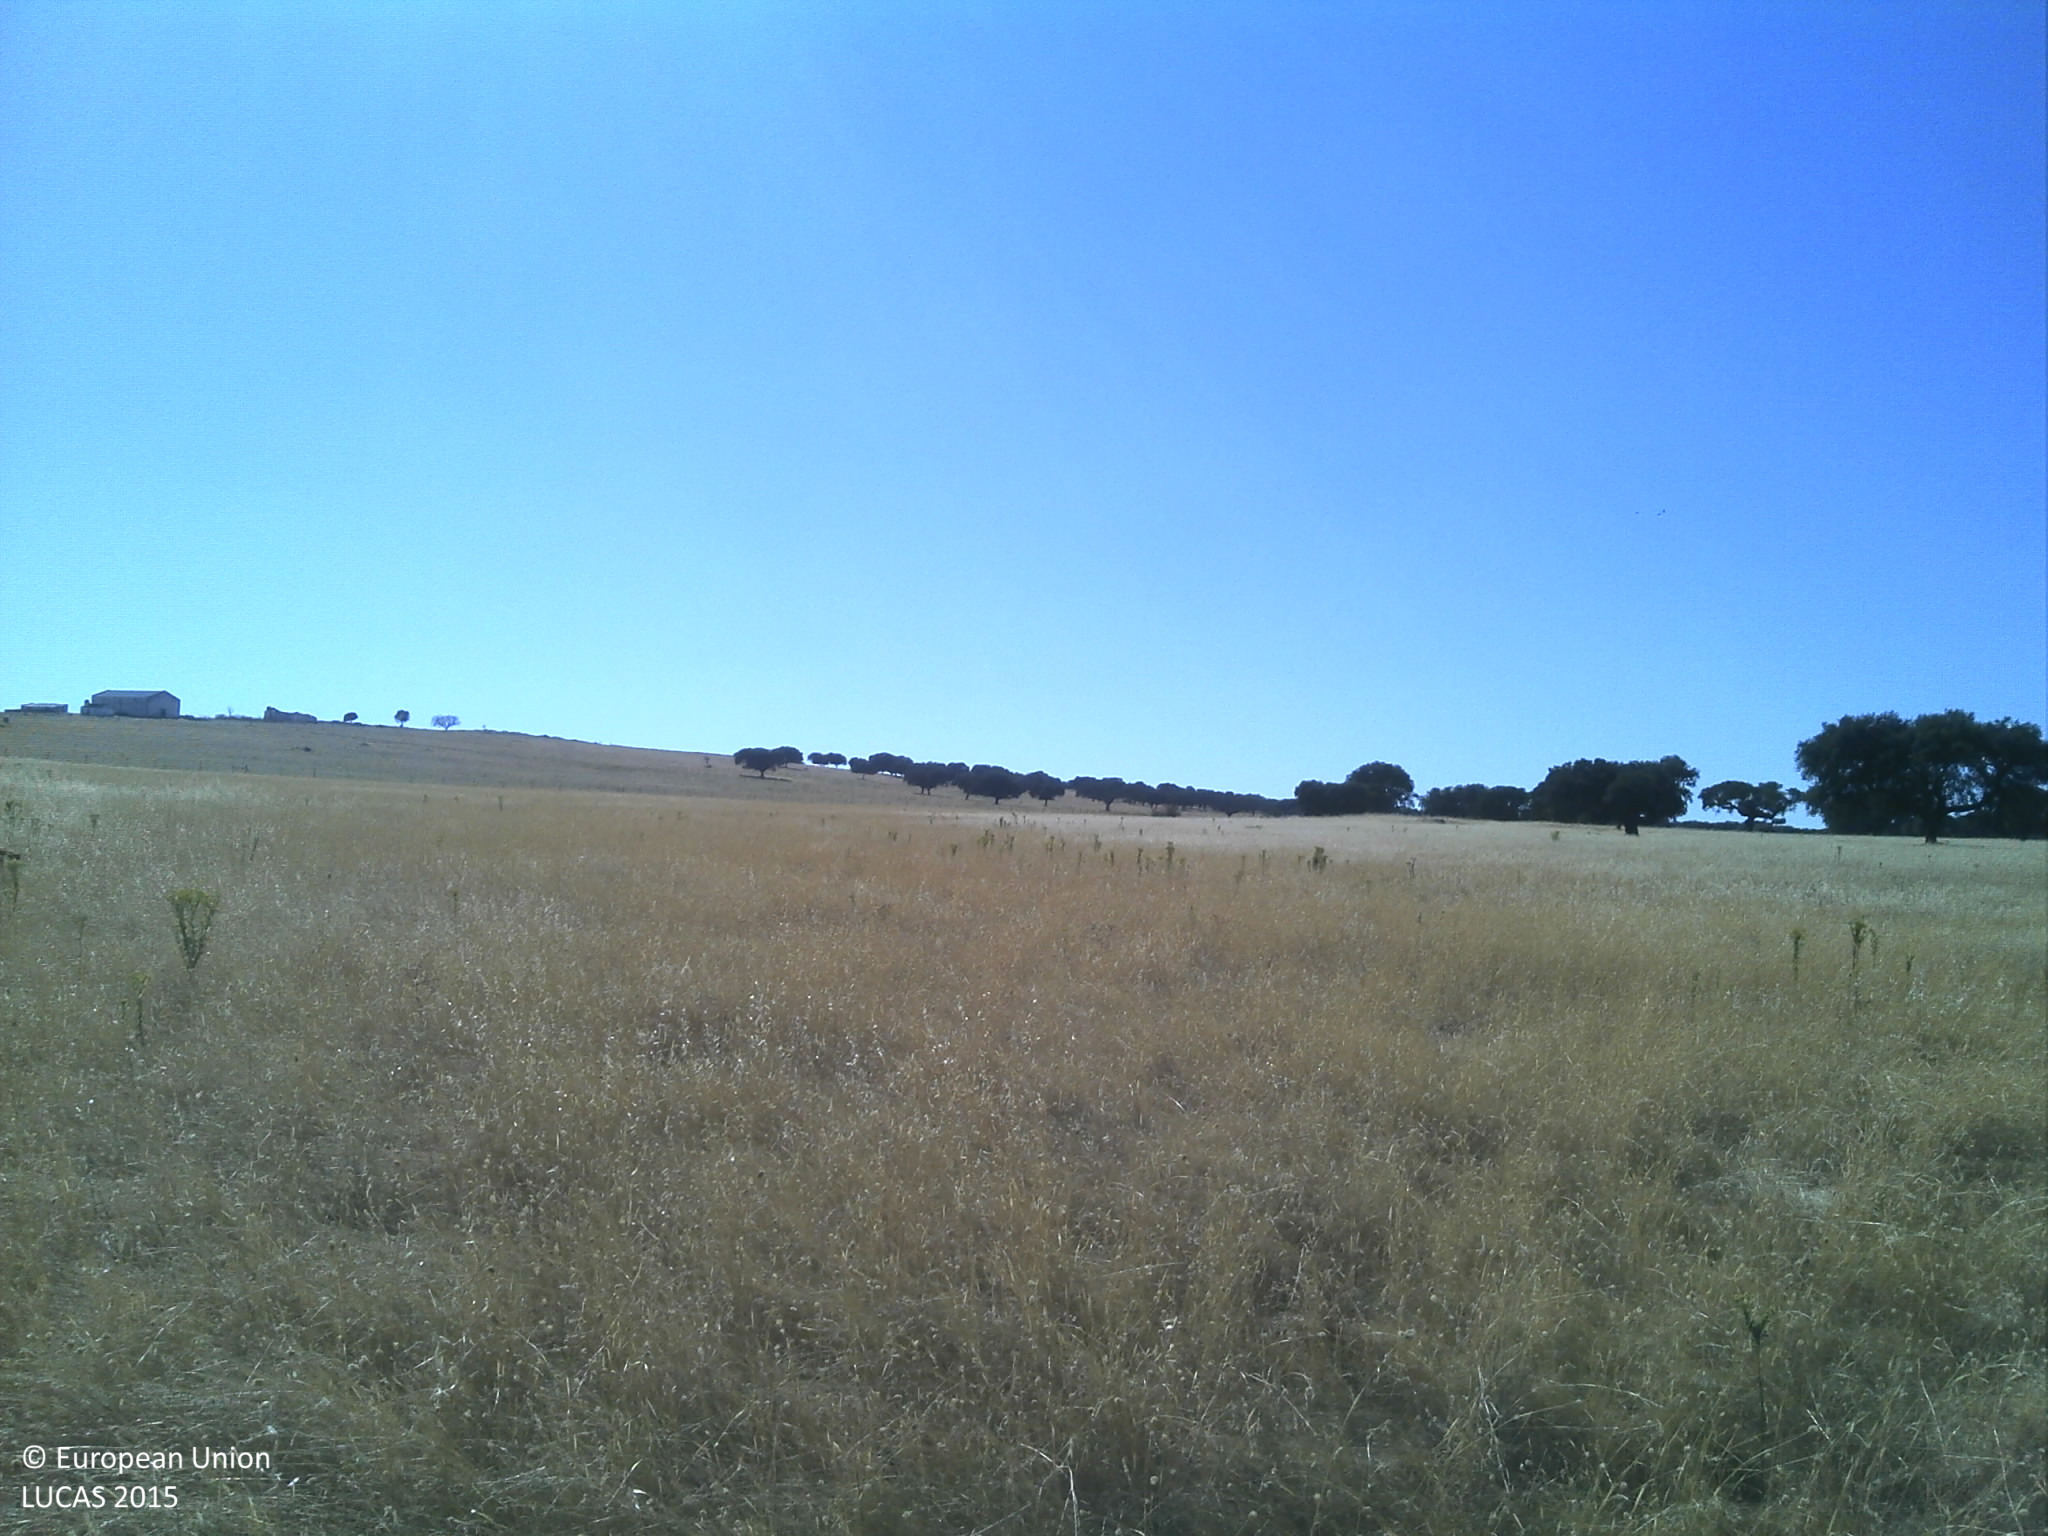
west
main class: Grassland
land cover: Grassland without tree/shrub cover
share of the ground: > 75 %
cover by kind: herbaceous plants 80 %, unconsolidated bare surface 20 %
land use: Agriculture (excluding fallow land and kitchen gardens)
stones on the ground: < 10 %
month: July
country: PT
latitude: 39.1184
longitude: -7.3271
